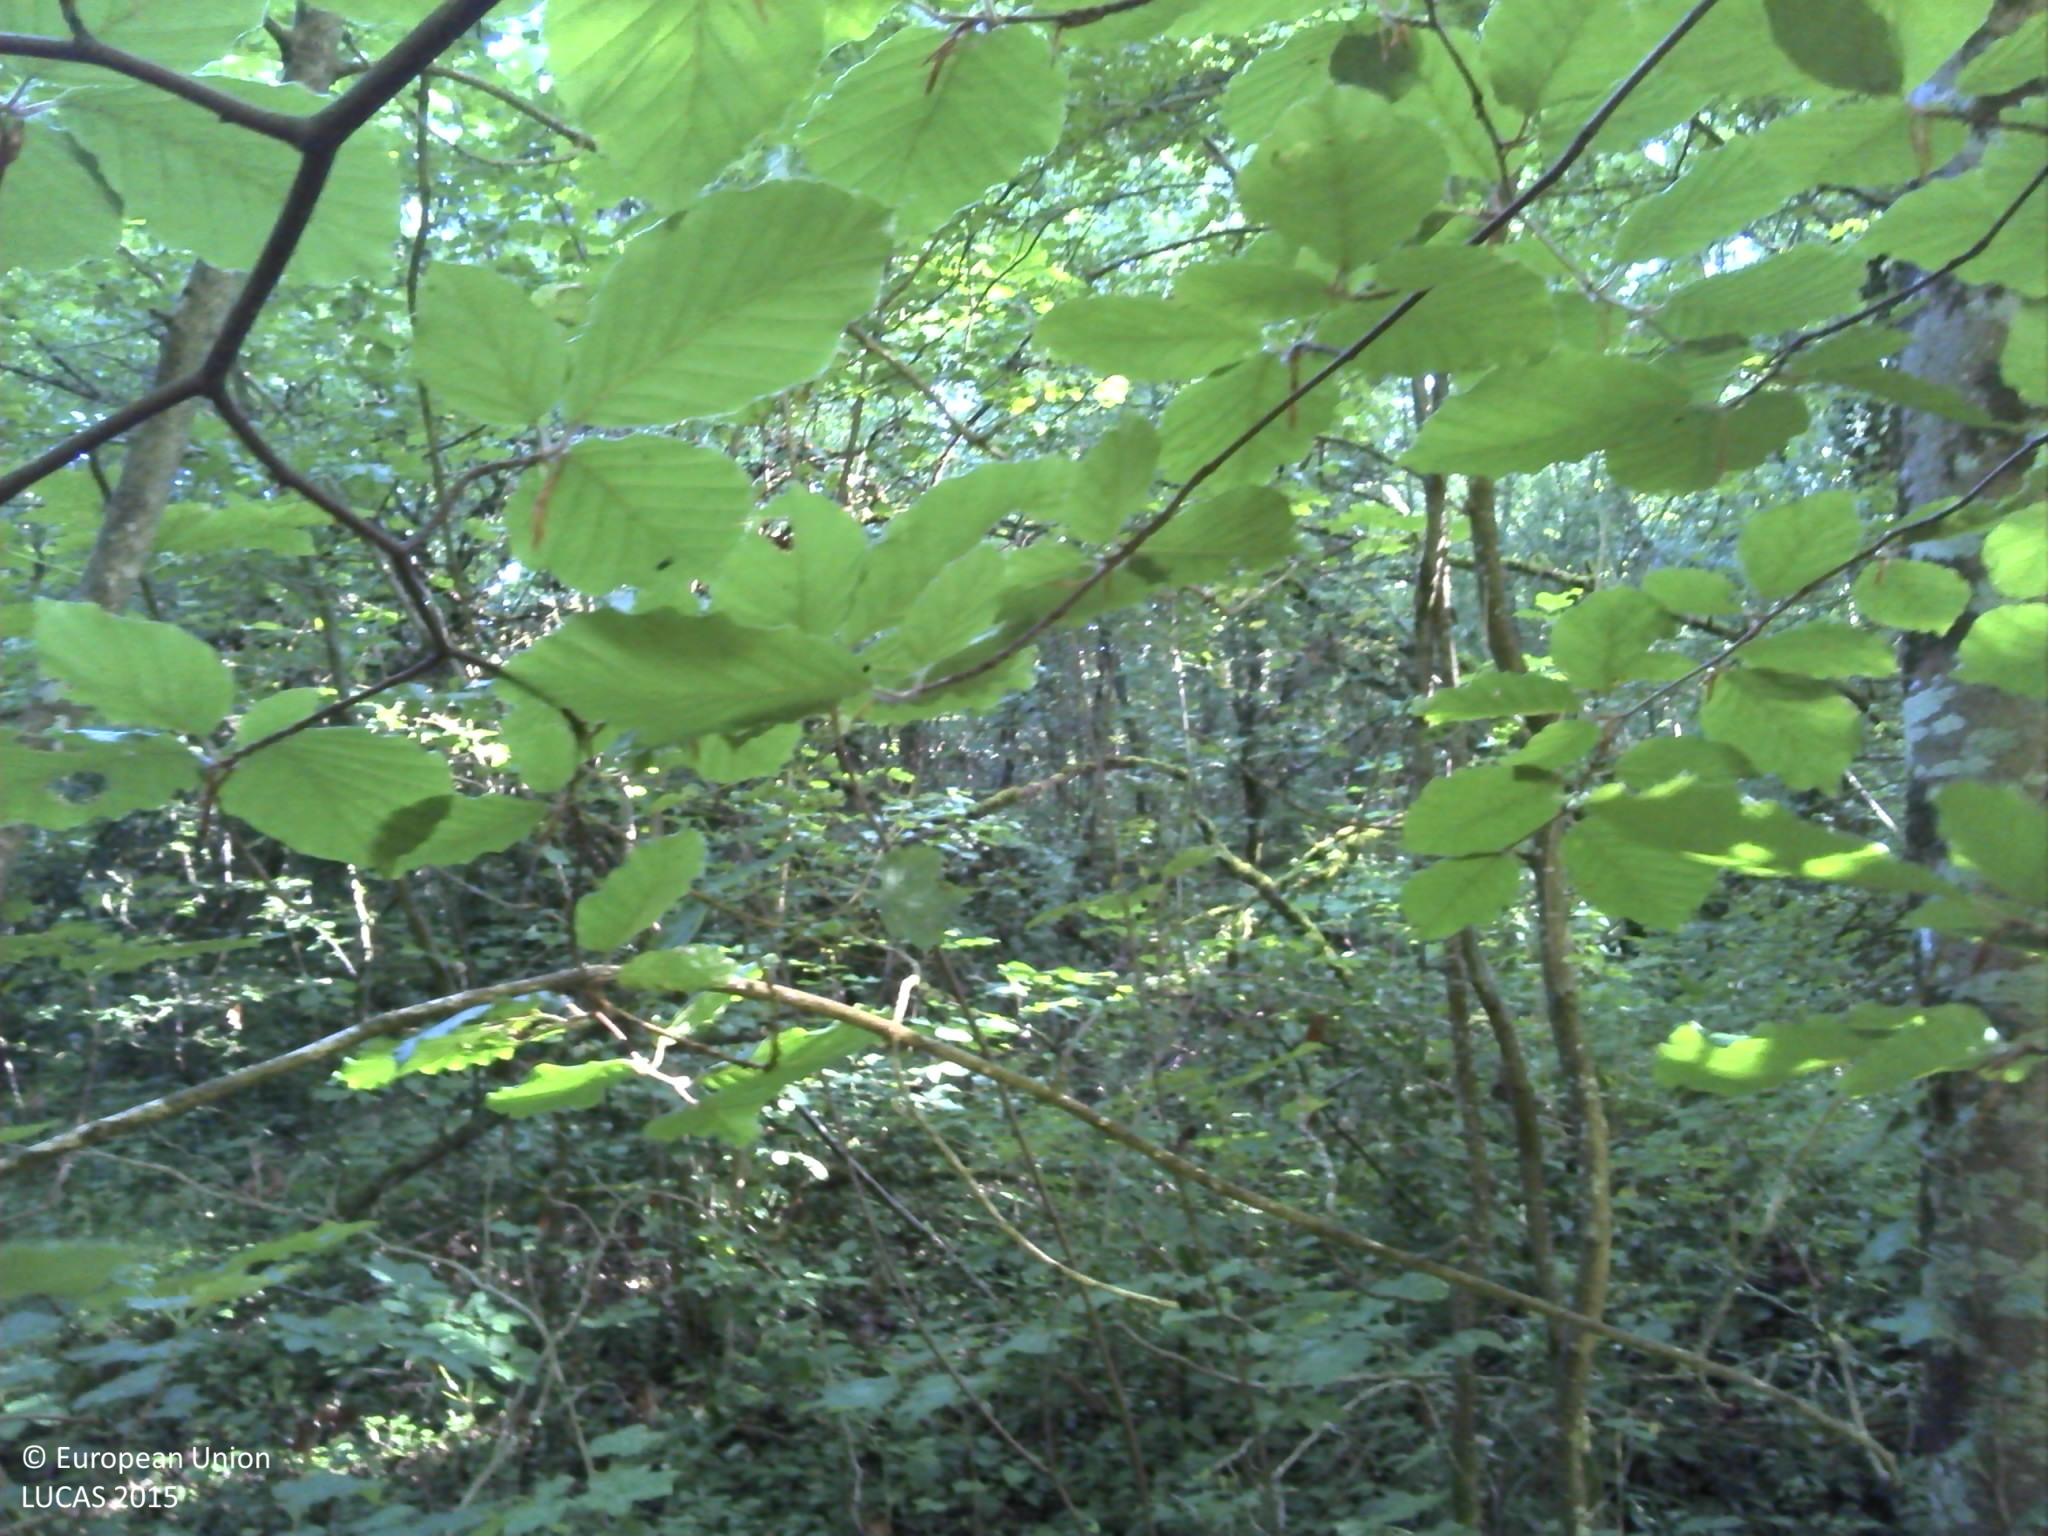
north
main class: Woodland
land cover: Broadleaved woodland
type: beech forest
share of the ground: > 75 %
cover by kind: broadleaved forest trees 70 %, herbaceous plants 20 %, consolidated bare surface 10 %
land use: Forestry
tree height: > 5 m
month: July
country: FR
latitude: 49.6103
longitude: 4.6963
